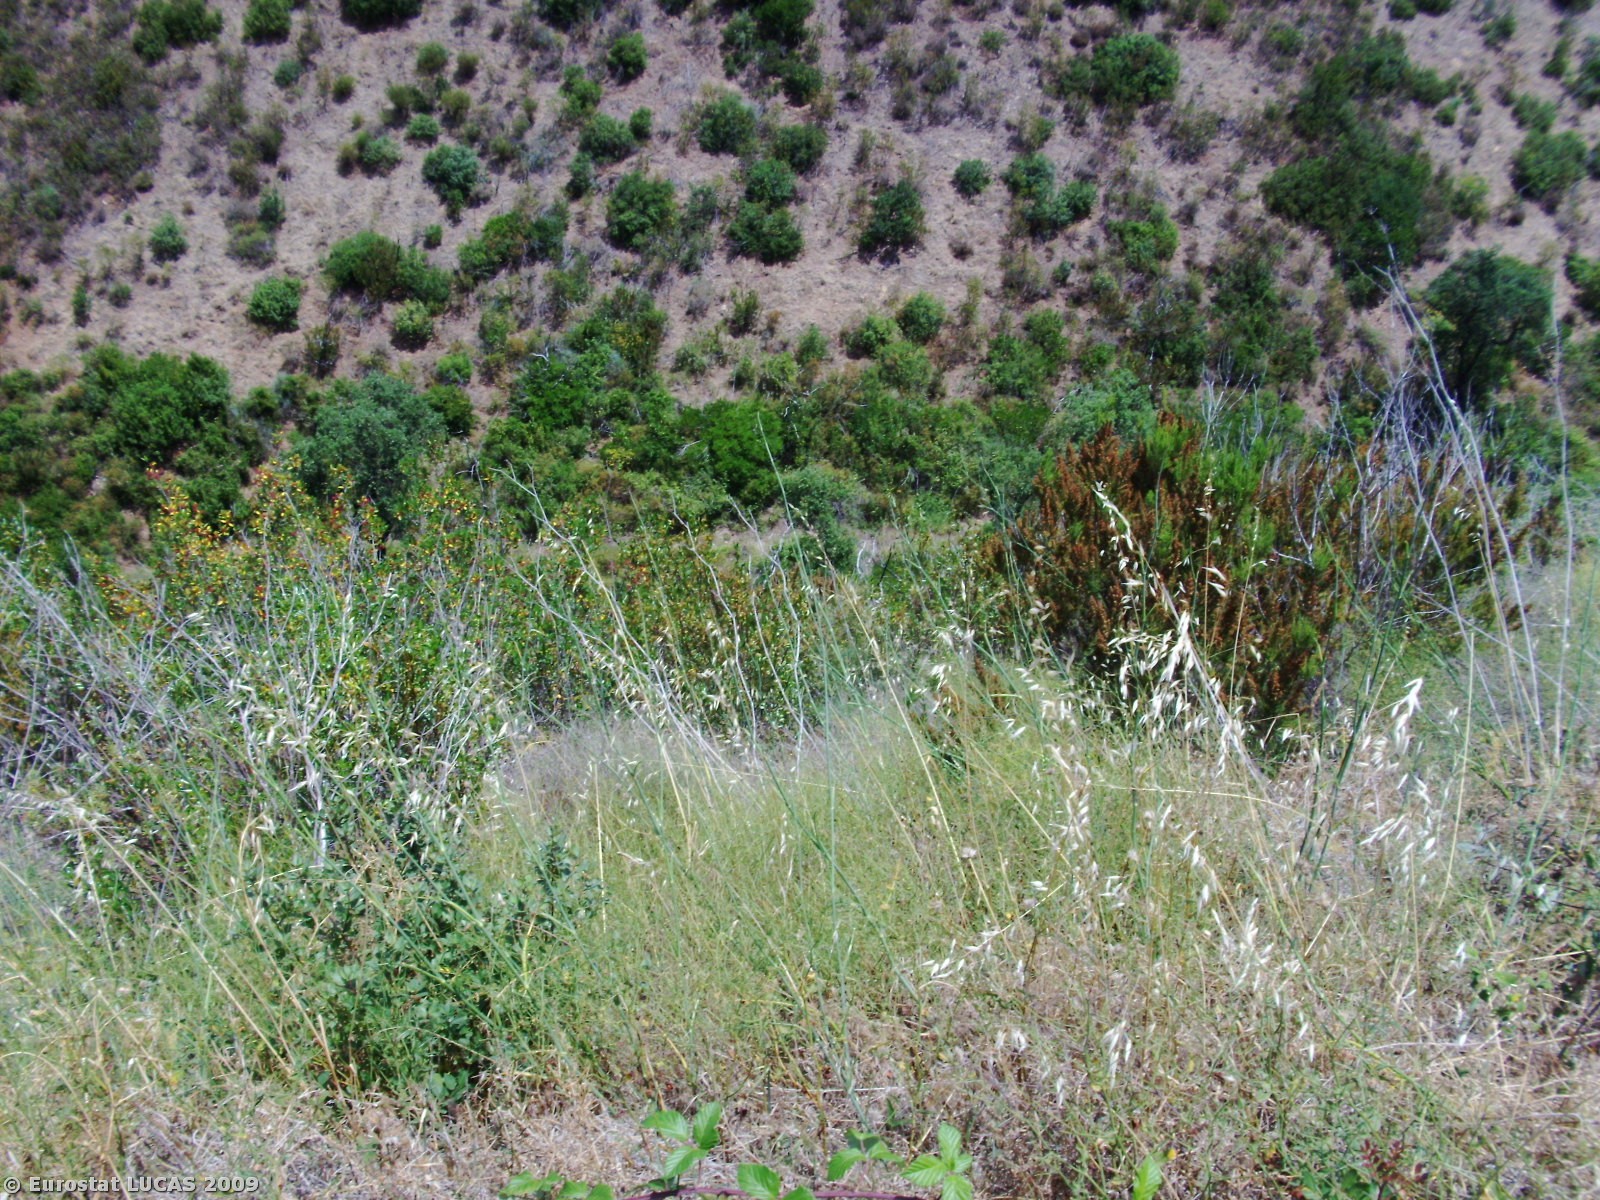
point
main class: Shrubland
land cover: Shrubland with sparse tree cover
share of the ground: > 75 %
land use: Nature reserves
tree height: < 5 m
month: June
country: PT
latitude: 37.3104
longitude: -8.7533
